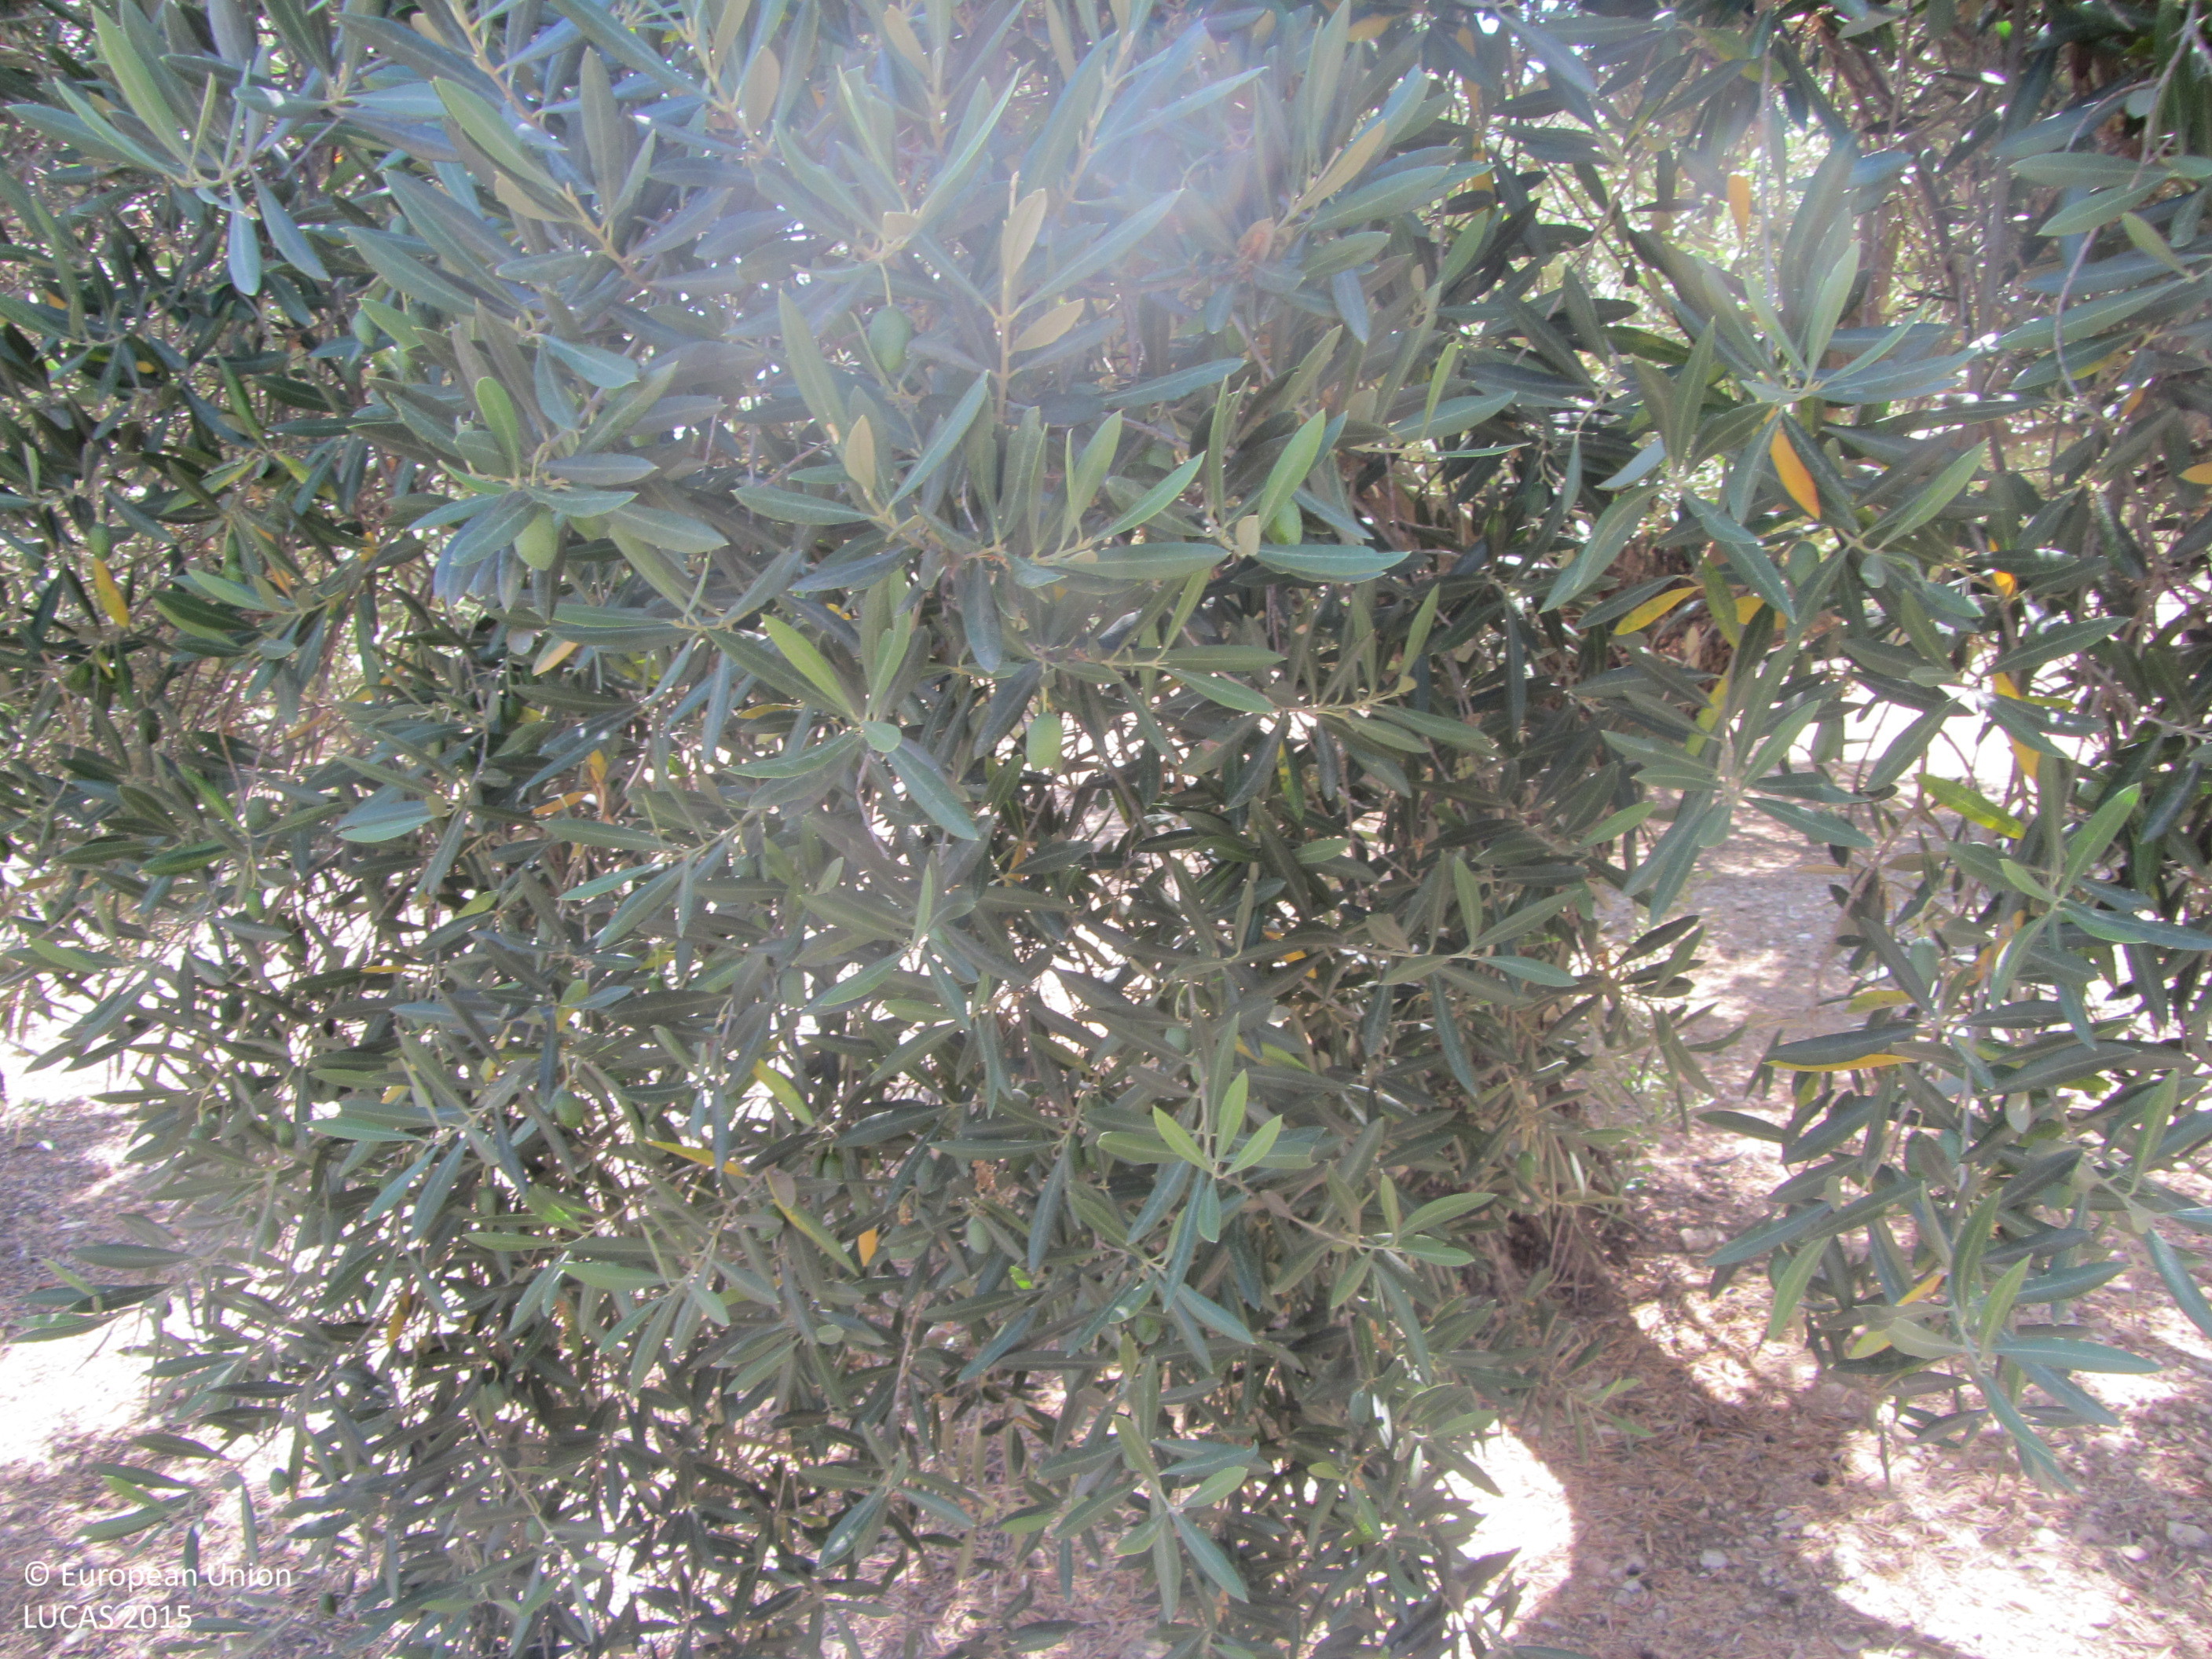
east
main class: Cropland
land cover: Olive groves
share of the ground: 50 - 75 %
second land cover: Other bare soil
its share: > 75 %
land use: Agriculture (excluding fallow land and kitchen gardens)
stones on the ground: 10 - 25 %
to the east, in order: Olive groves; Other bare soil; Grassland with sparse tree/shrub cover; Broadleaved woodland; Olive groves
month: July
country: ES
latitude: 37.9827
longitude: -3.8145
